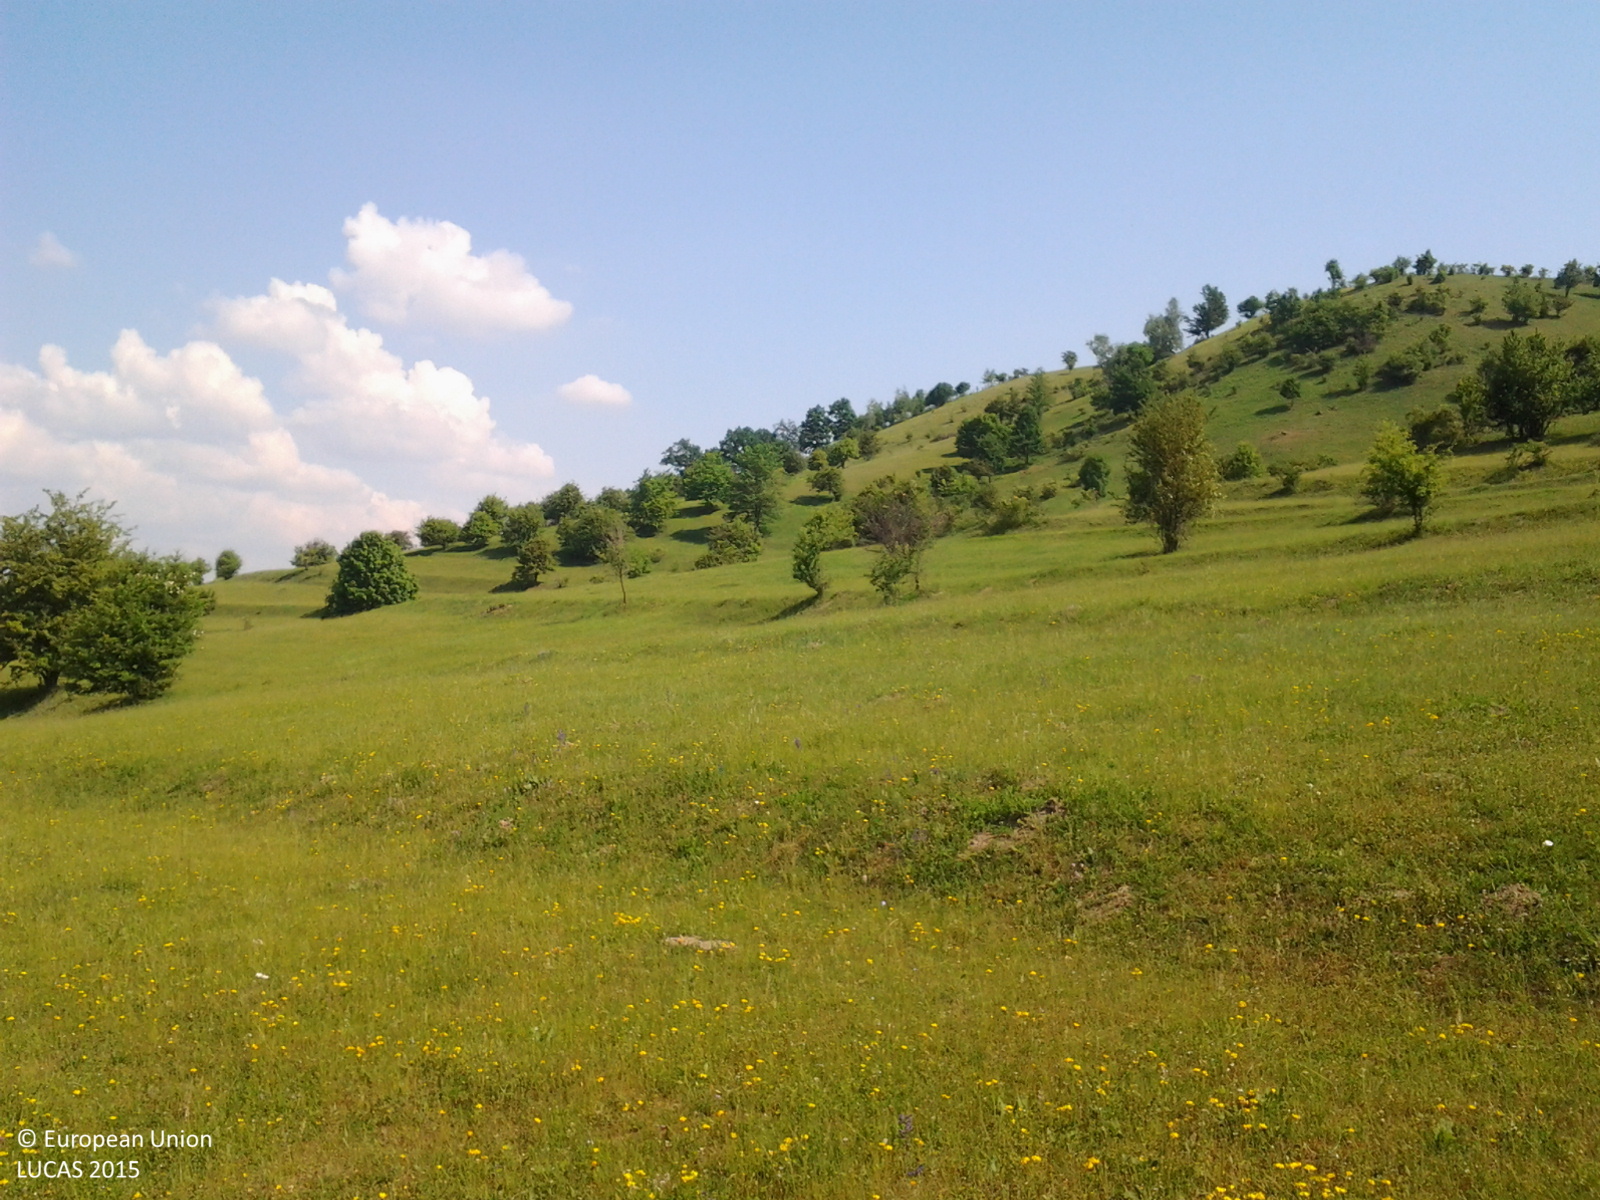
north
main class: Grassland
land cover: Grassland without tree/shrub cover
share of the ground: > 75 %
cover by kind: herbaceous plants 100 %
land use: Agriculture (excluding fallow land and kitchen gardens)
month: June
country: RO
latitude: 46.3456
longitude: 26.4915
